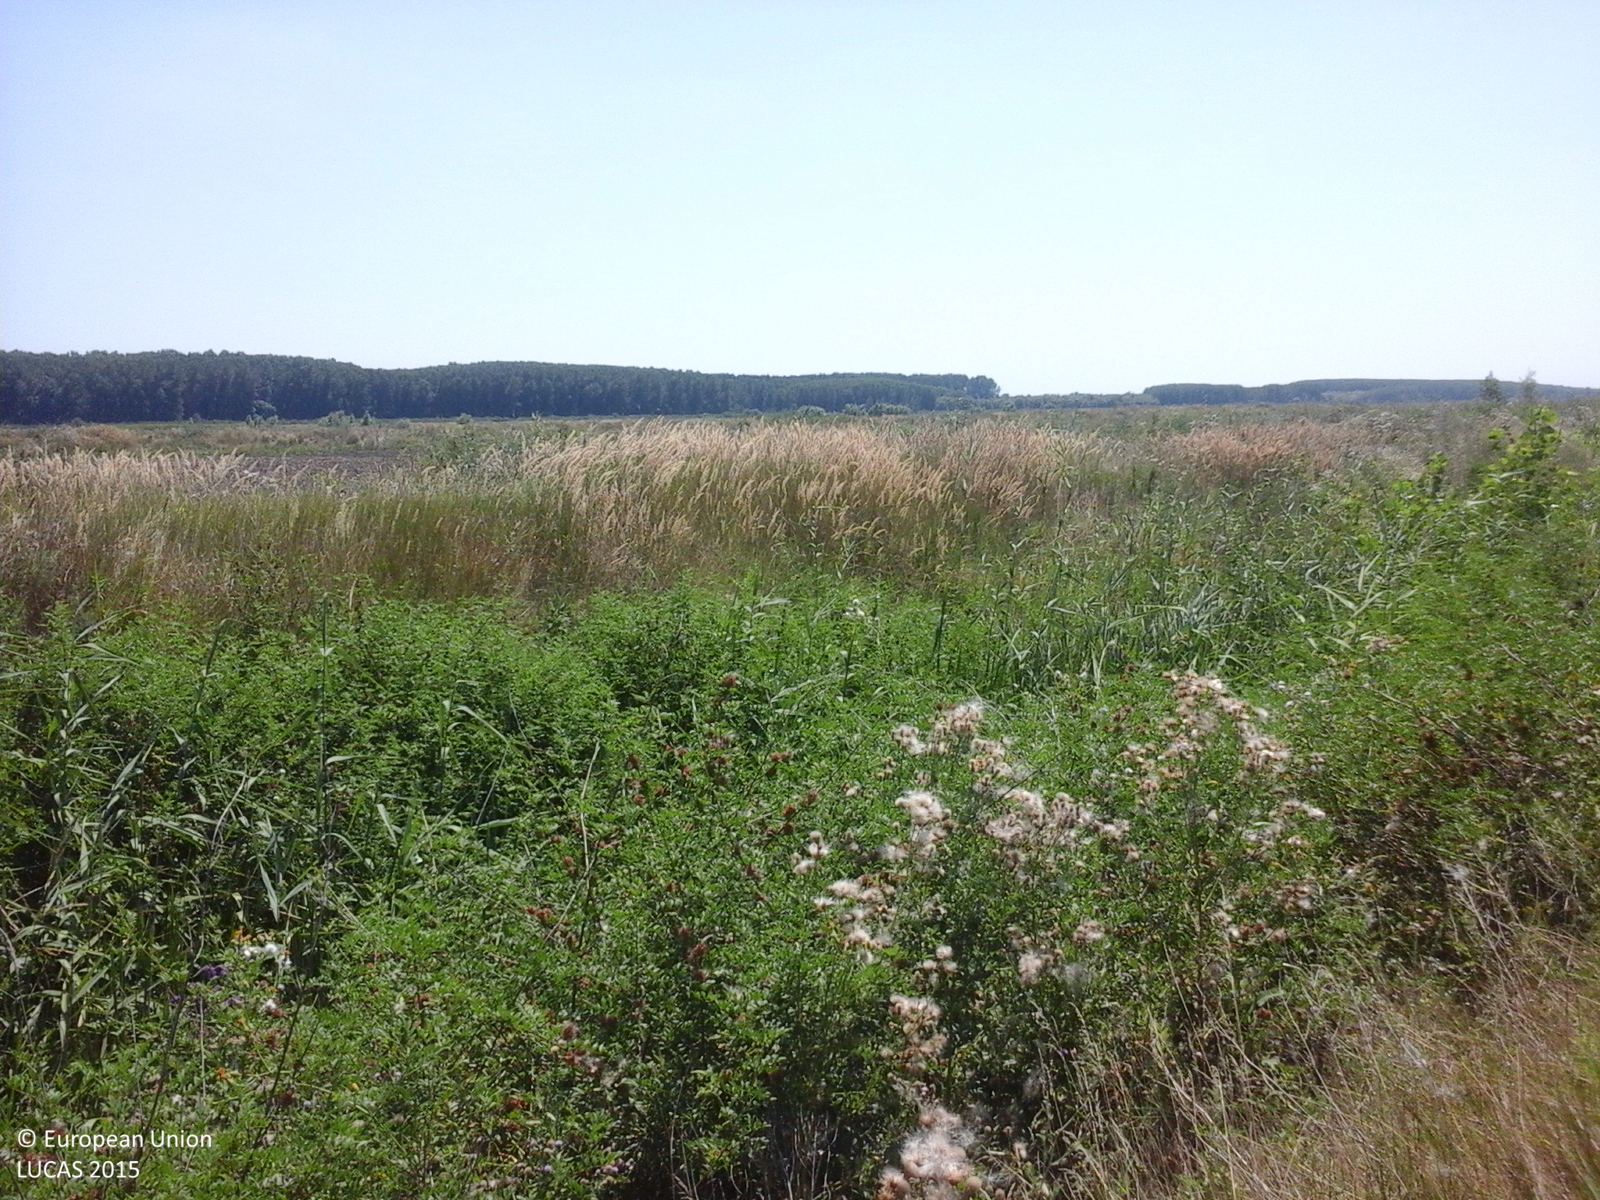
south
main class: Grassland
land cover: Spontaneously vegetated surfaces
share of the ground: > 75 %
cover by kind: herbaceous plants 100 %
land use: Semi-natural and natural areas not in use
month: July
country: RO
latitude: 44.1602
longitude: 27.4824
